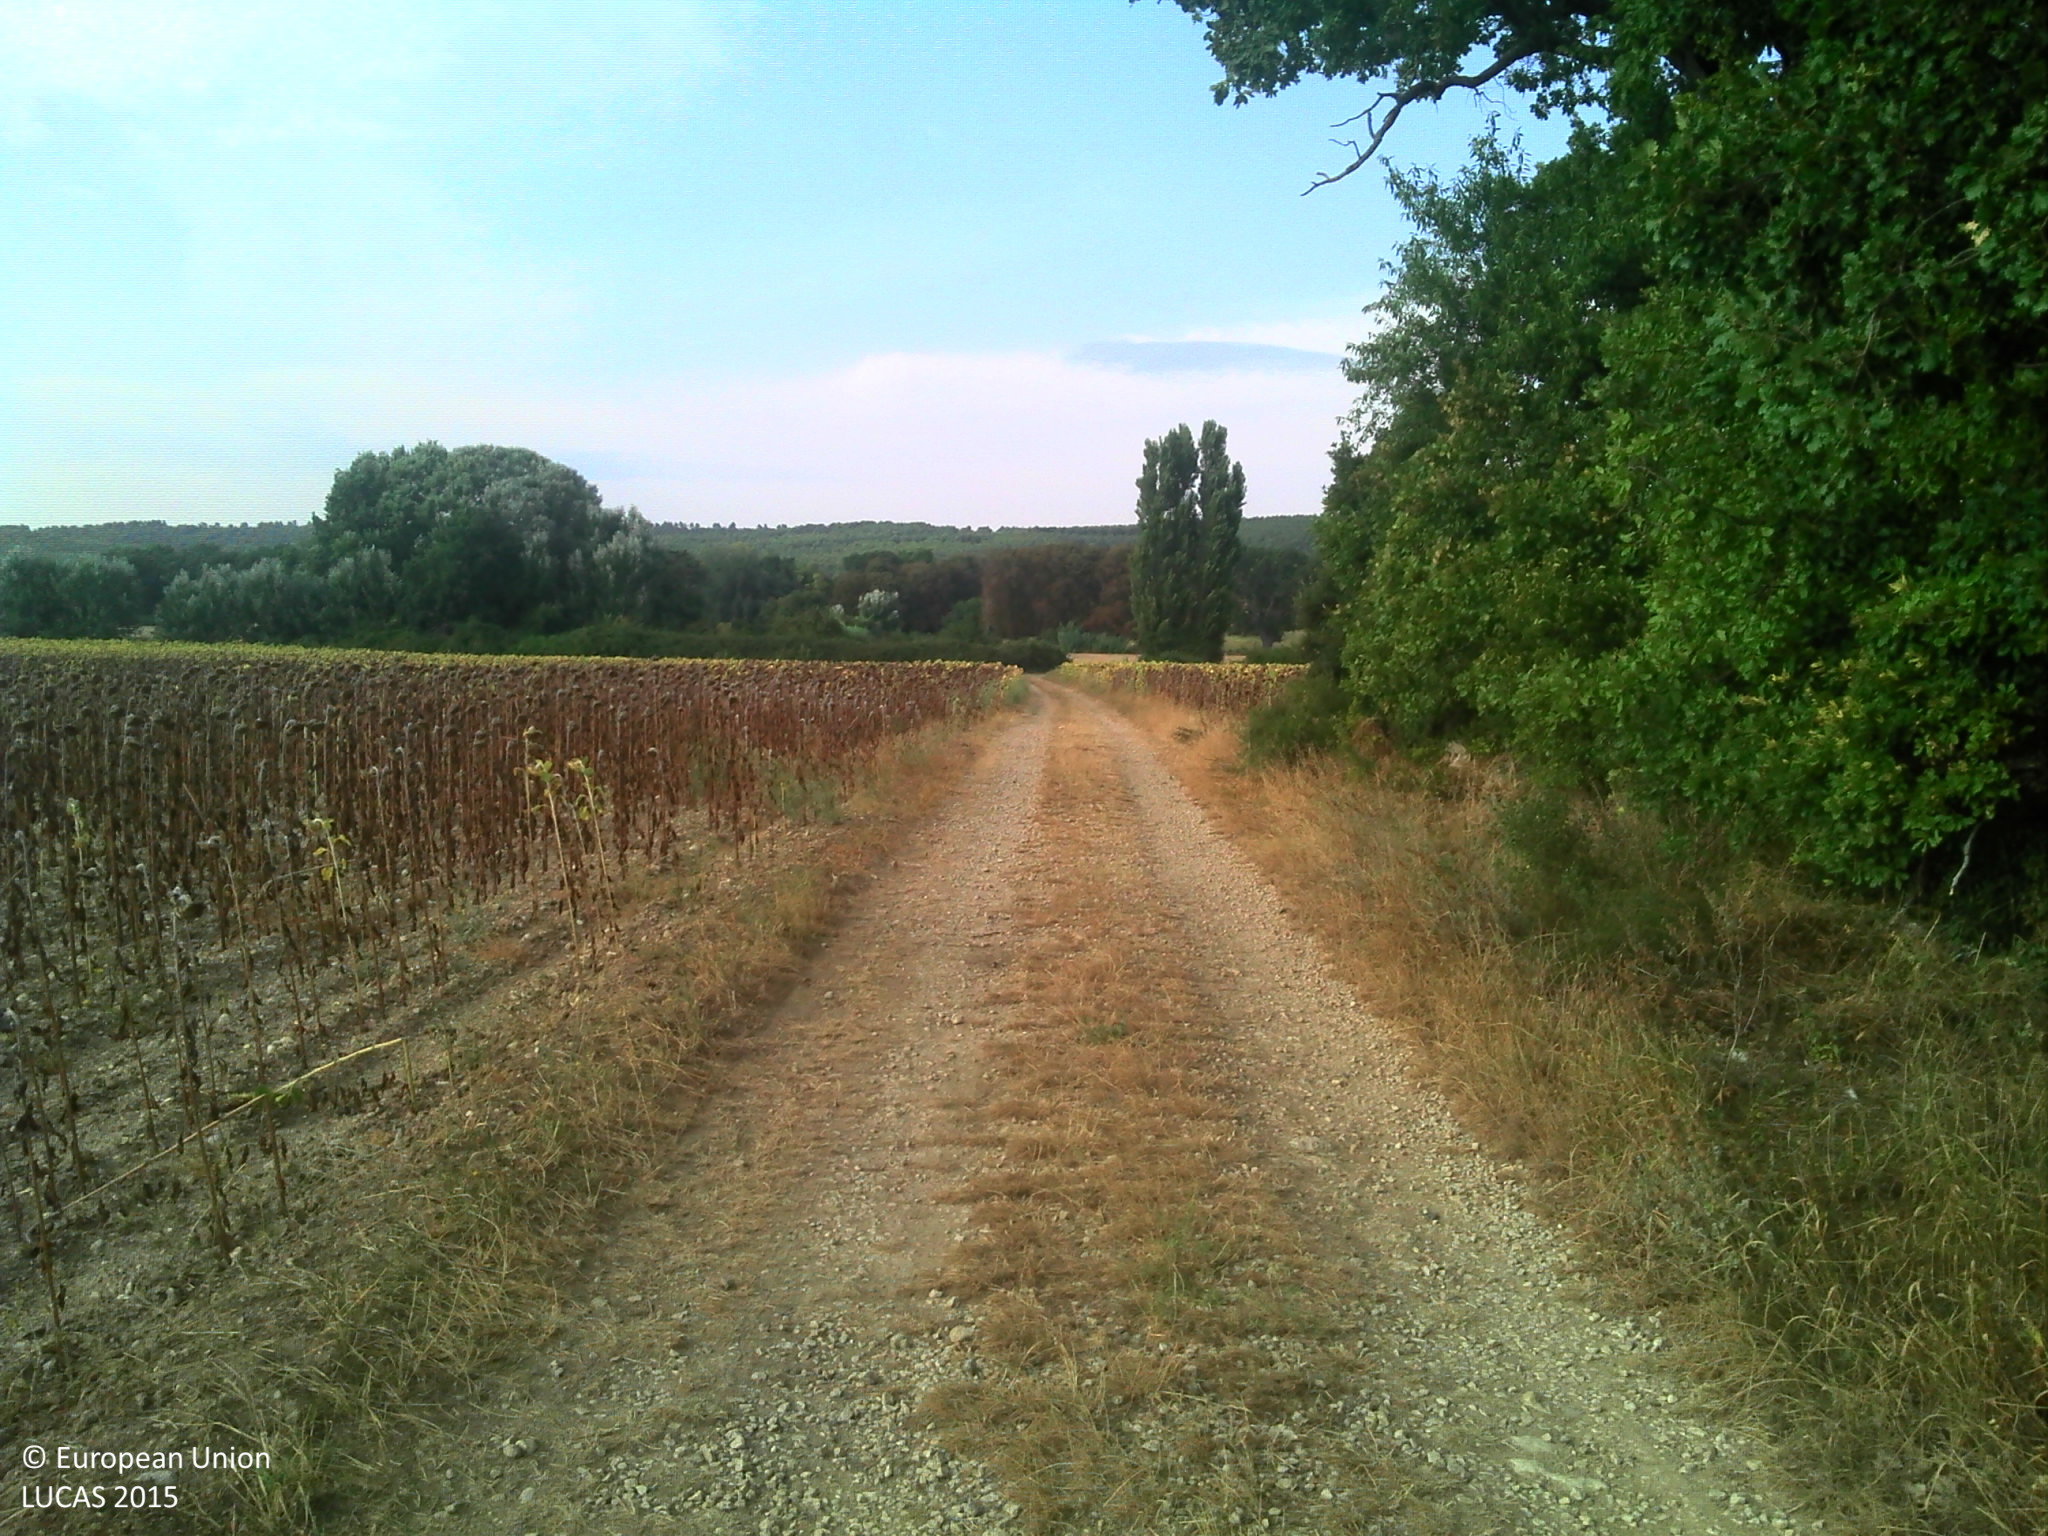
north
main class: Cropland
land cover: Sunflower
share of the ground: 25 - 50 %
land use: Agriculture (excluding fallow land and kitchen gardens)
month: August
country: FR
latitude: 43.5977
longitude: 5.3890
